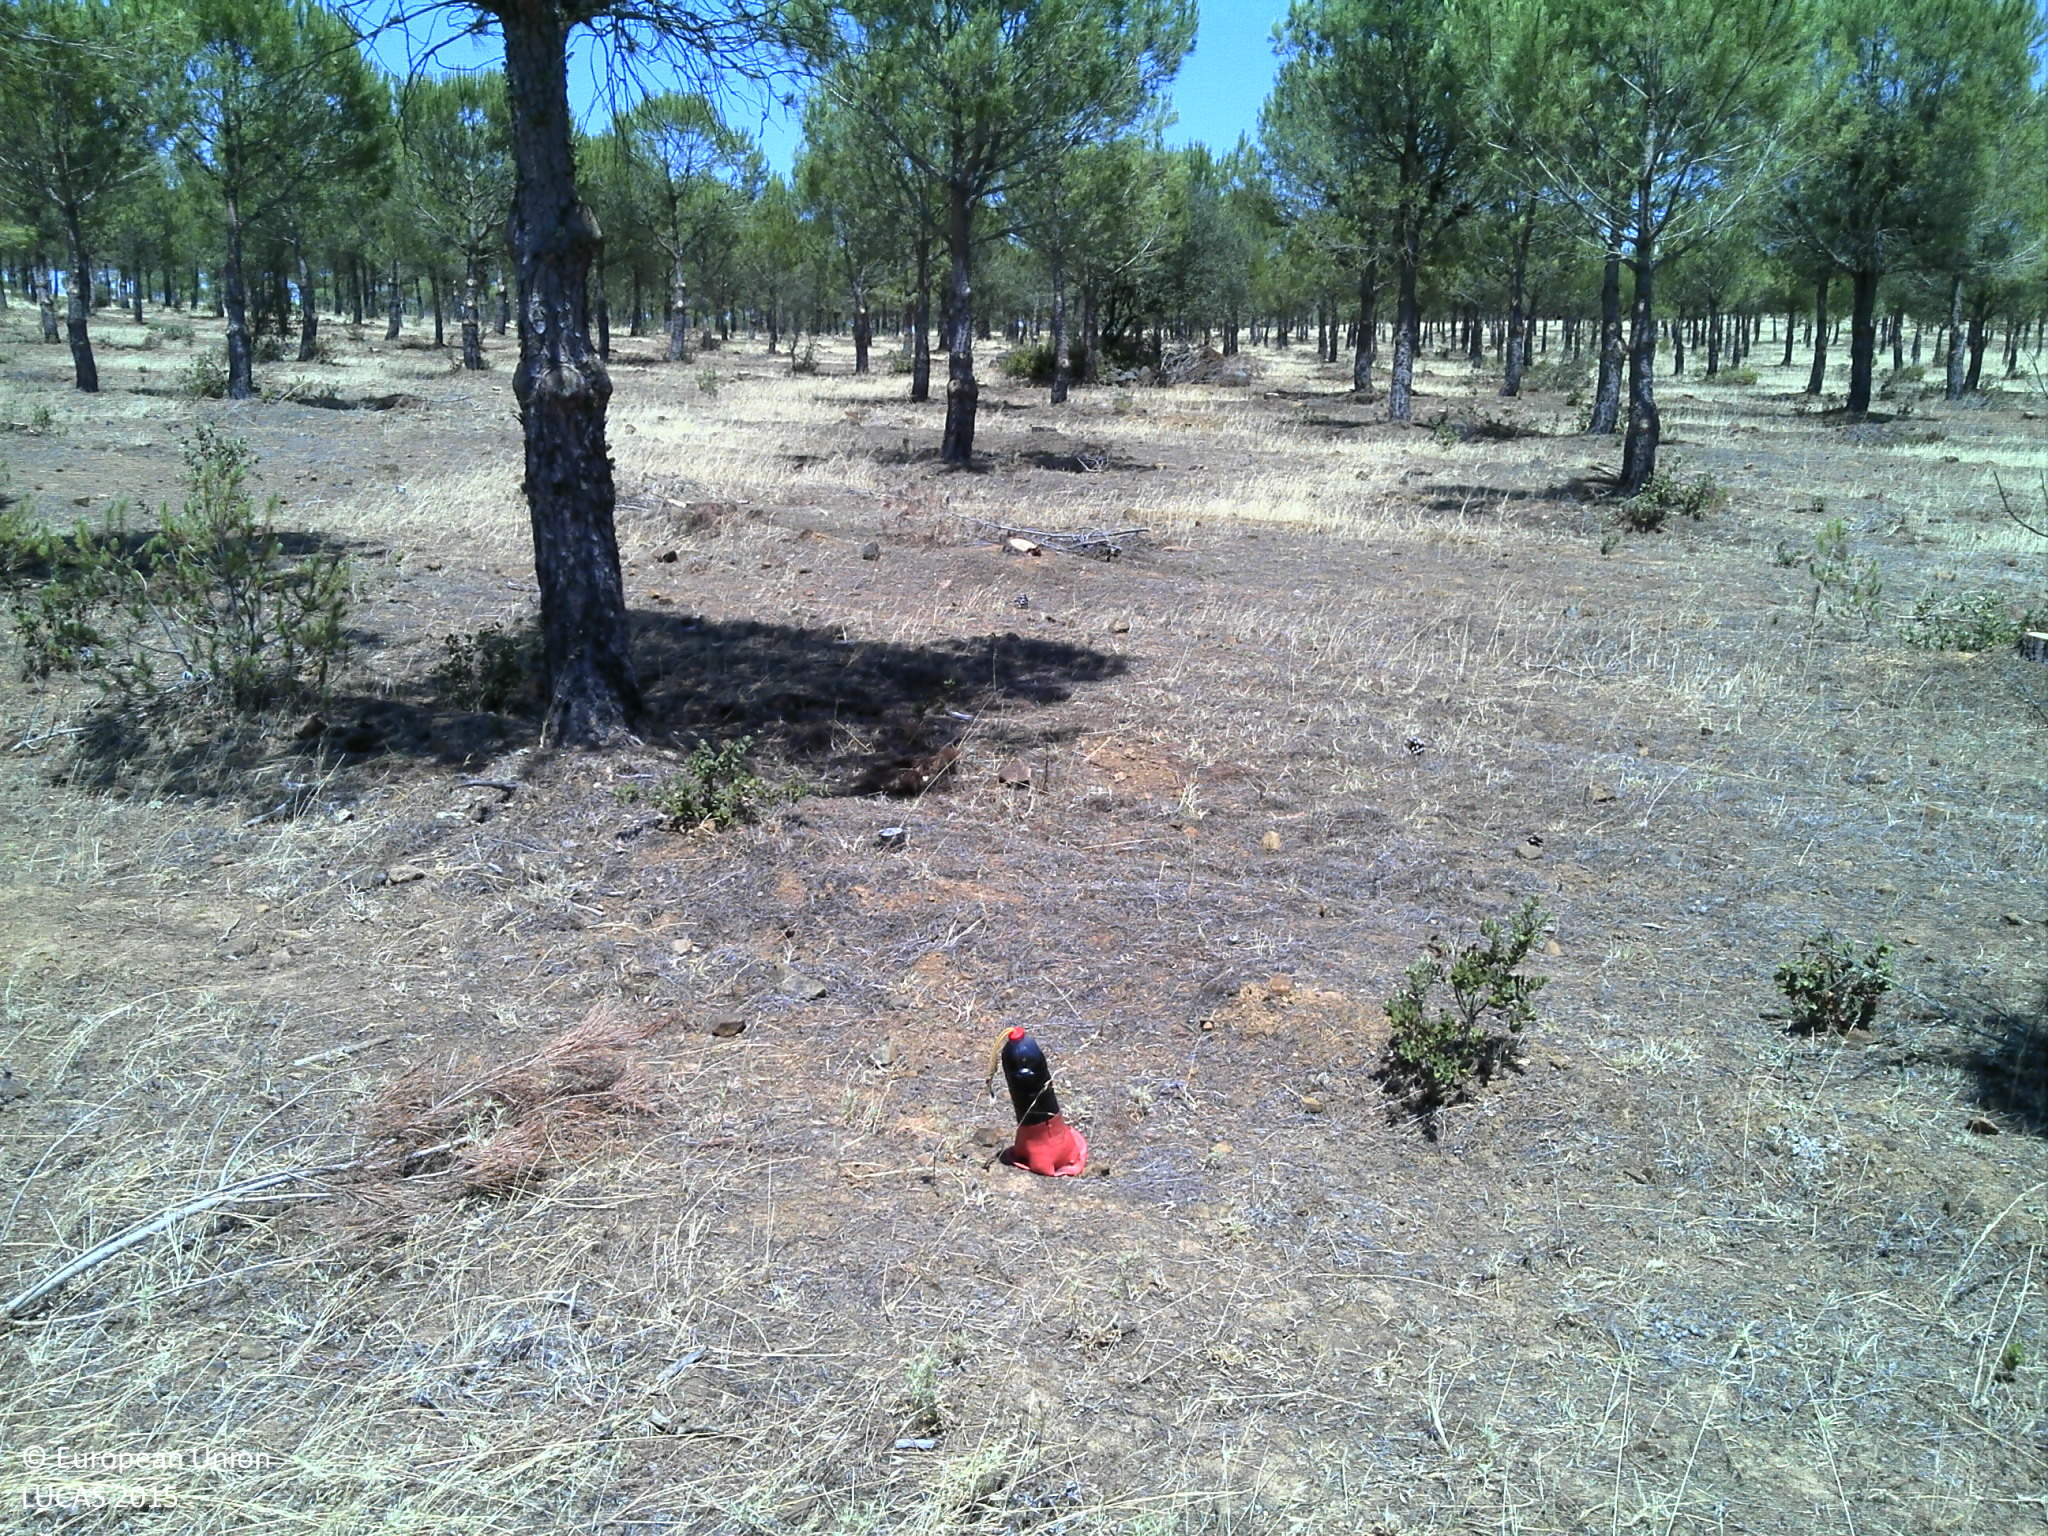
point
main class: Woodland
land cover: Pine dominated coniferous woodland
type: coniferous forest of the mediterranean region
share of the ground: 25 - 50 %
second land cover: Grassland without tree/shrub cover
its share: 10 - 25 %
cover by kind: unconsolidated bare surface 50 %, coniferous forest trees 40 %, herbaceous plants 10 %
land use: Forestry
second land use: Agriculture (excluding fallow land and kitchen gardens)
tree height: > 5 m
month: June
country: PT
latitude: 38.1381
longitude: -8.0266
